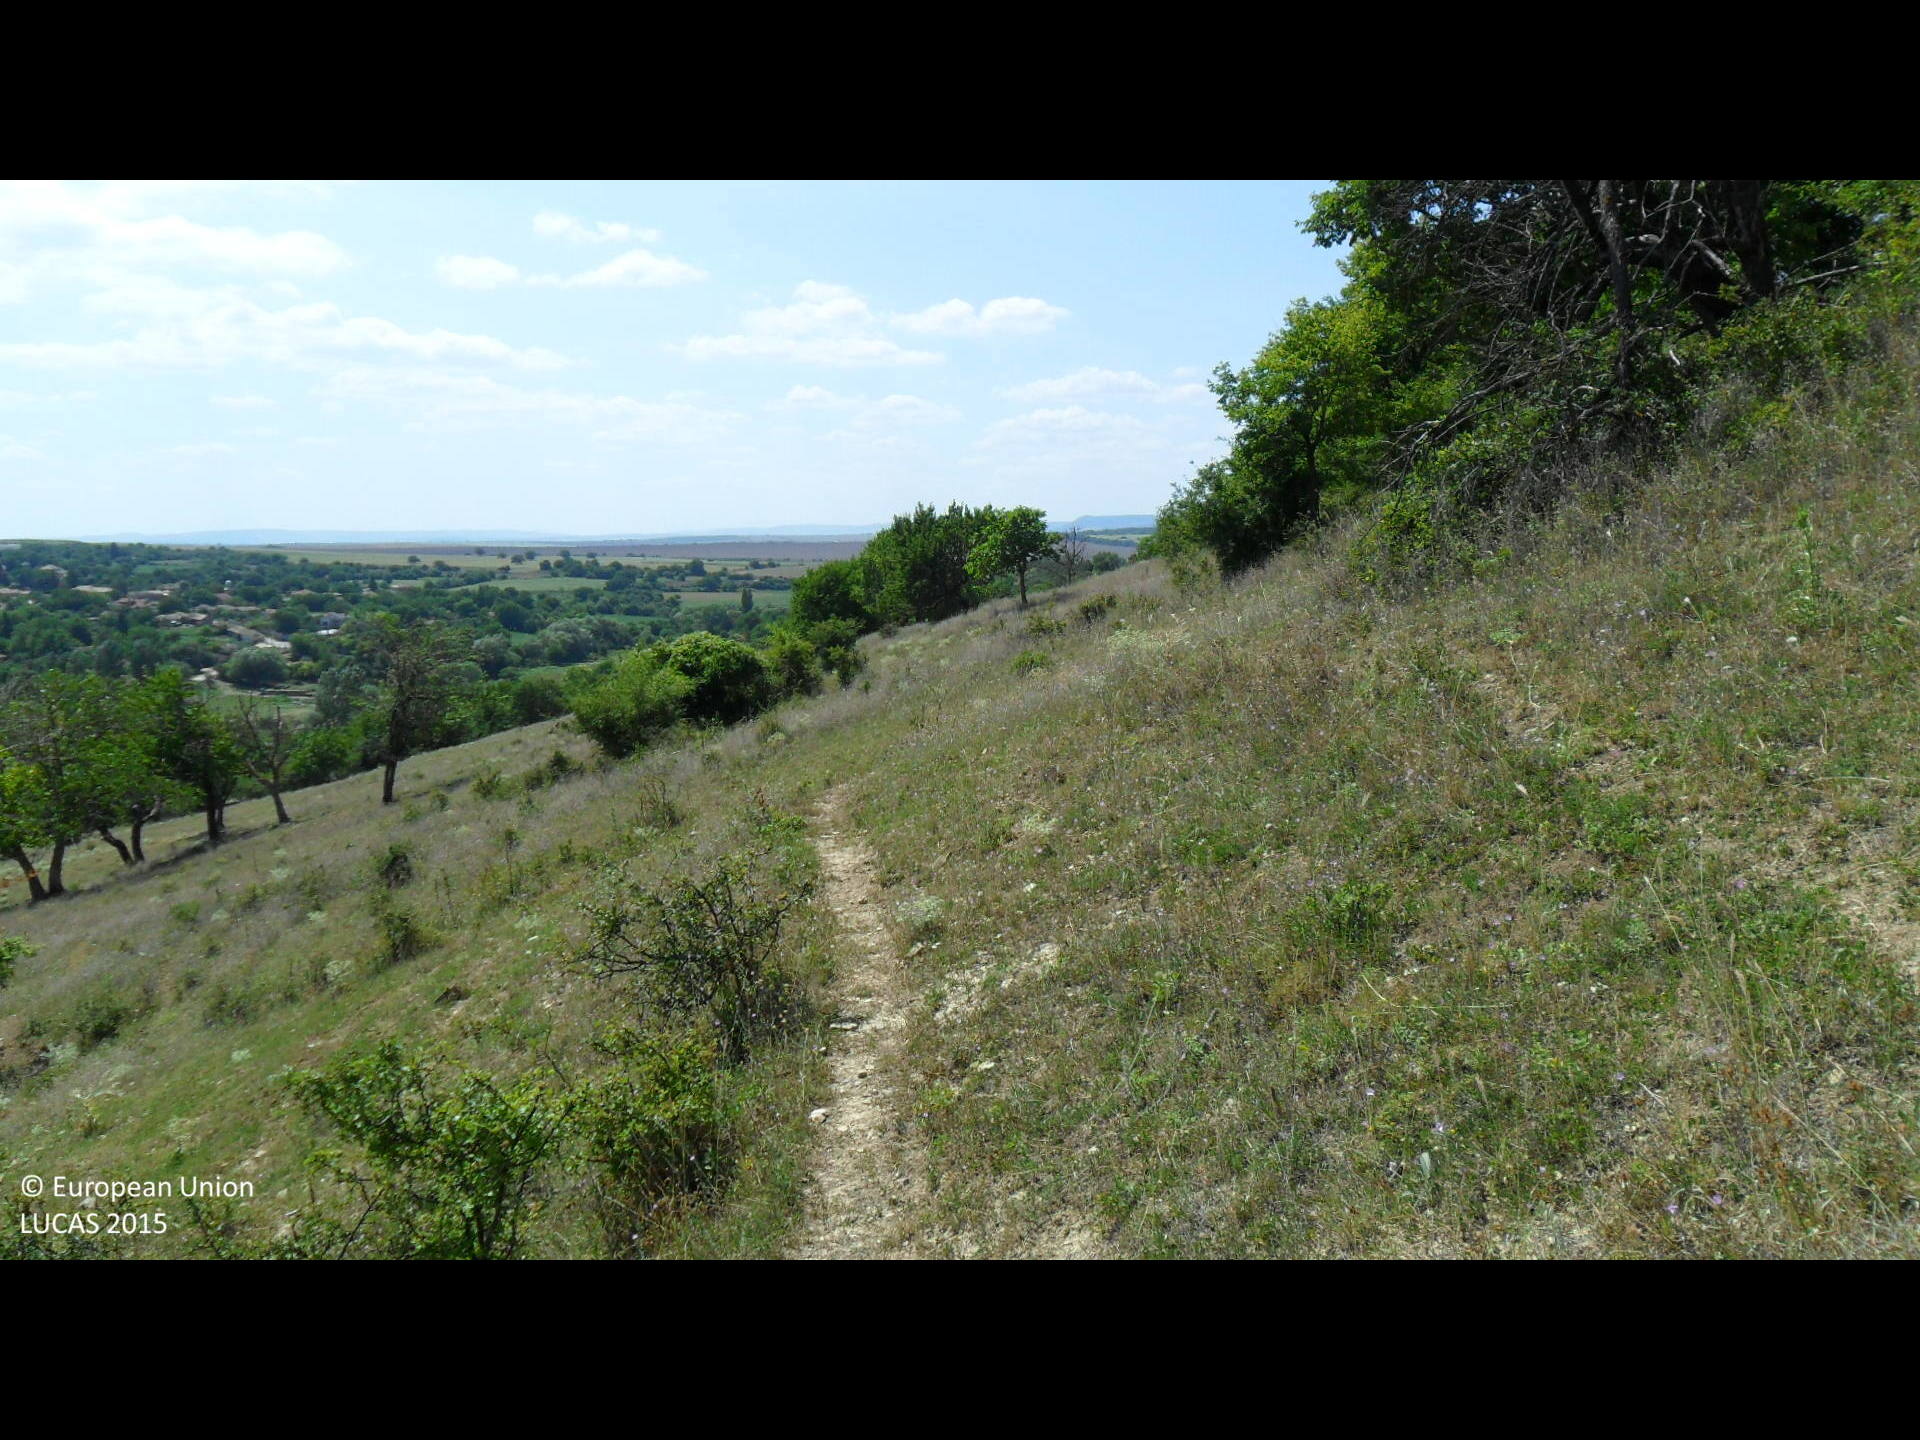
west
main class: Grassland
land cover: Grassland with sparse tree/shrub cover
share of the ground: > 75 %
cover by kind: herbaceous plants 90 %, broadleaved forest trees 5 %, shrubs 5 %
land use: Agriculture (excluding fallow land and kitchen gardens)
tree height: < 5 m
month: August
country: BG
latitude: 43.4357
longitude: 26.4221
